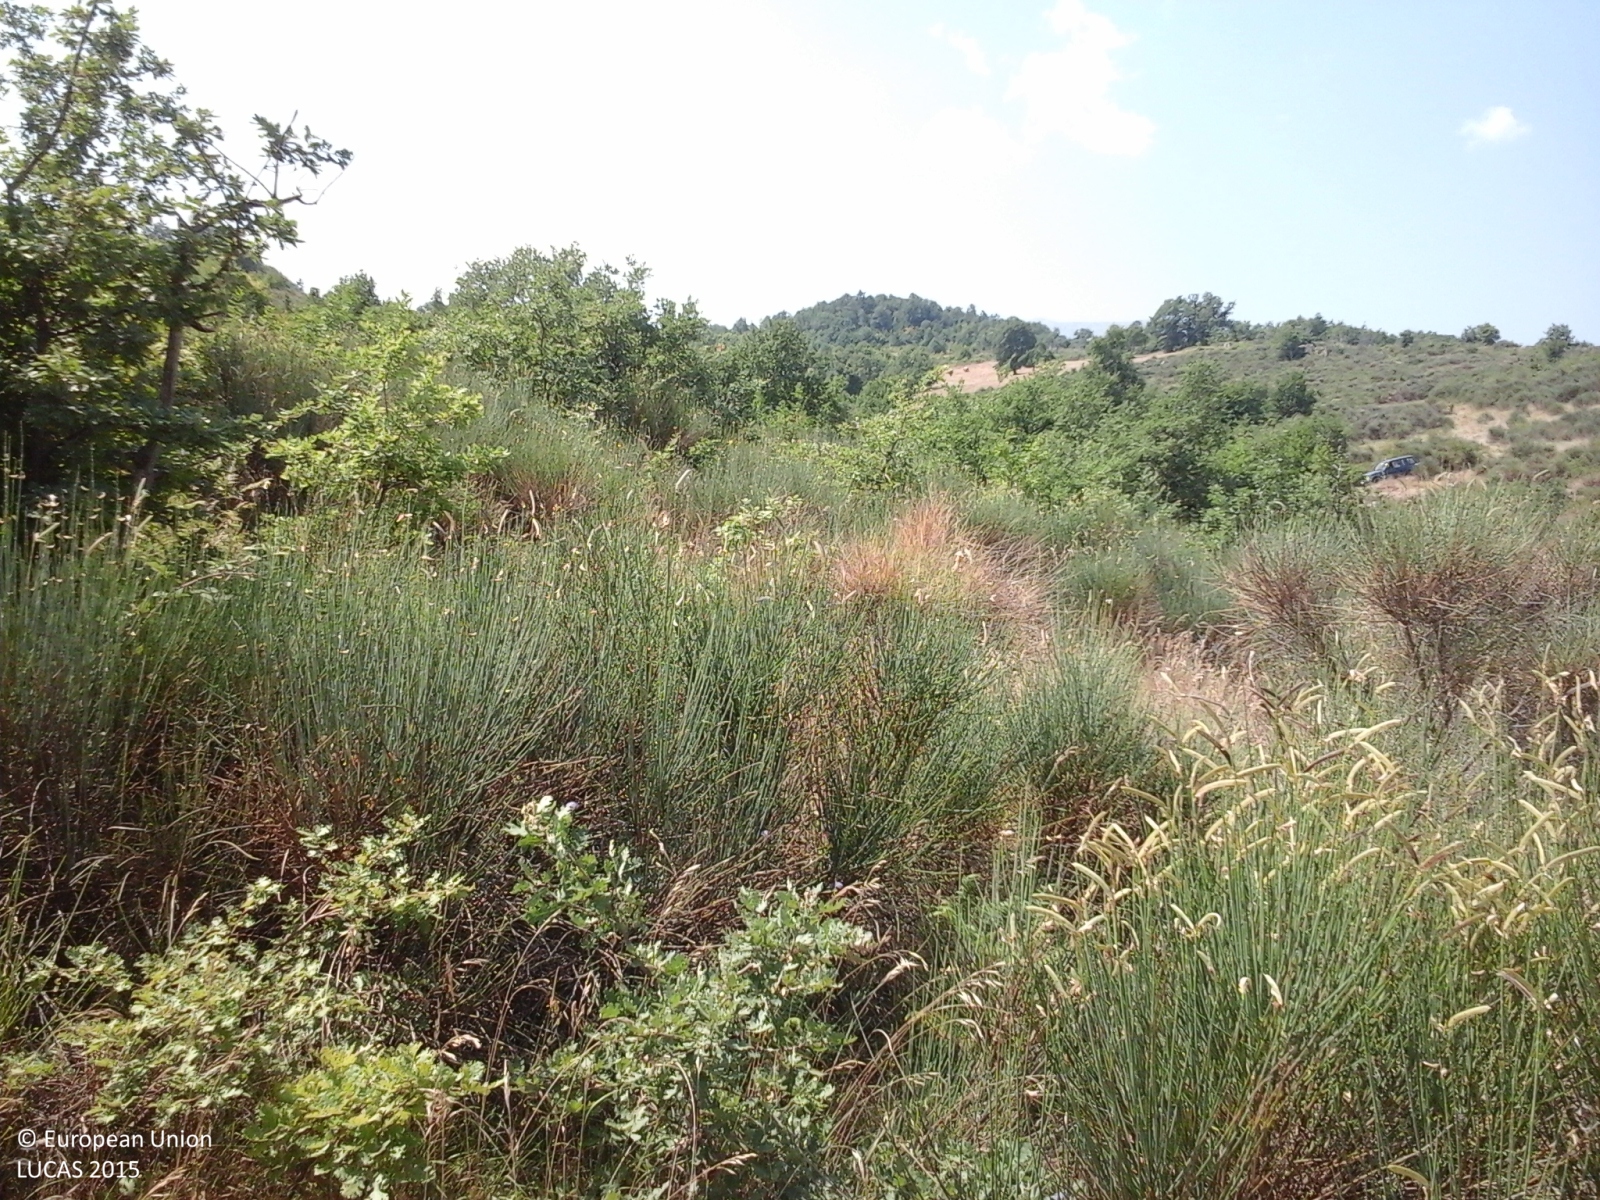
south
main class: Shrubland
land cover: Shrubland without tree cover
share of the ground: > 75 %
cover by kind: shrubs 90 %, herbaceous plants 10 %
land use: Semi-natural and natural areas not in use
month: July
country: IT
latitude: 42.1945
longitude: 14.0197
